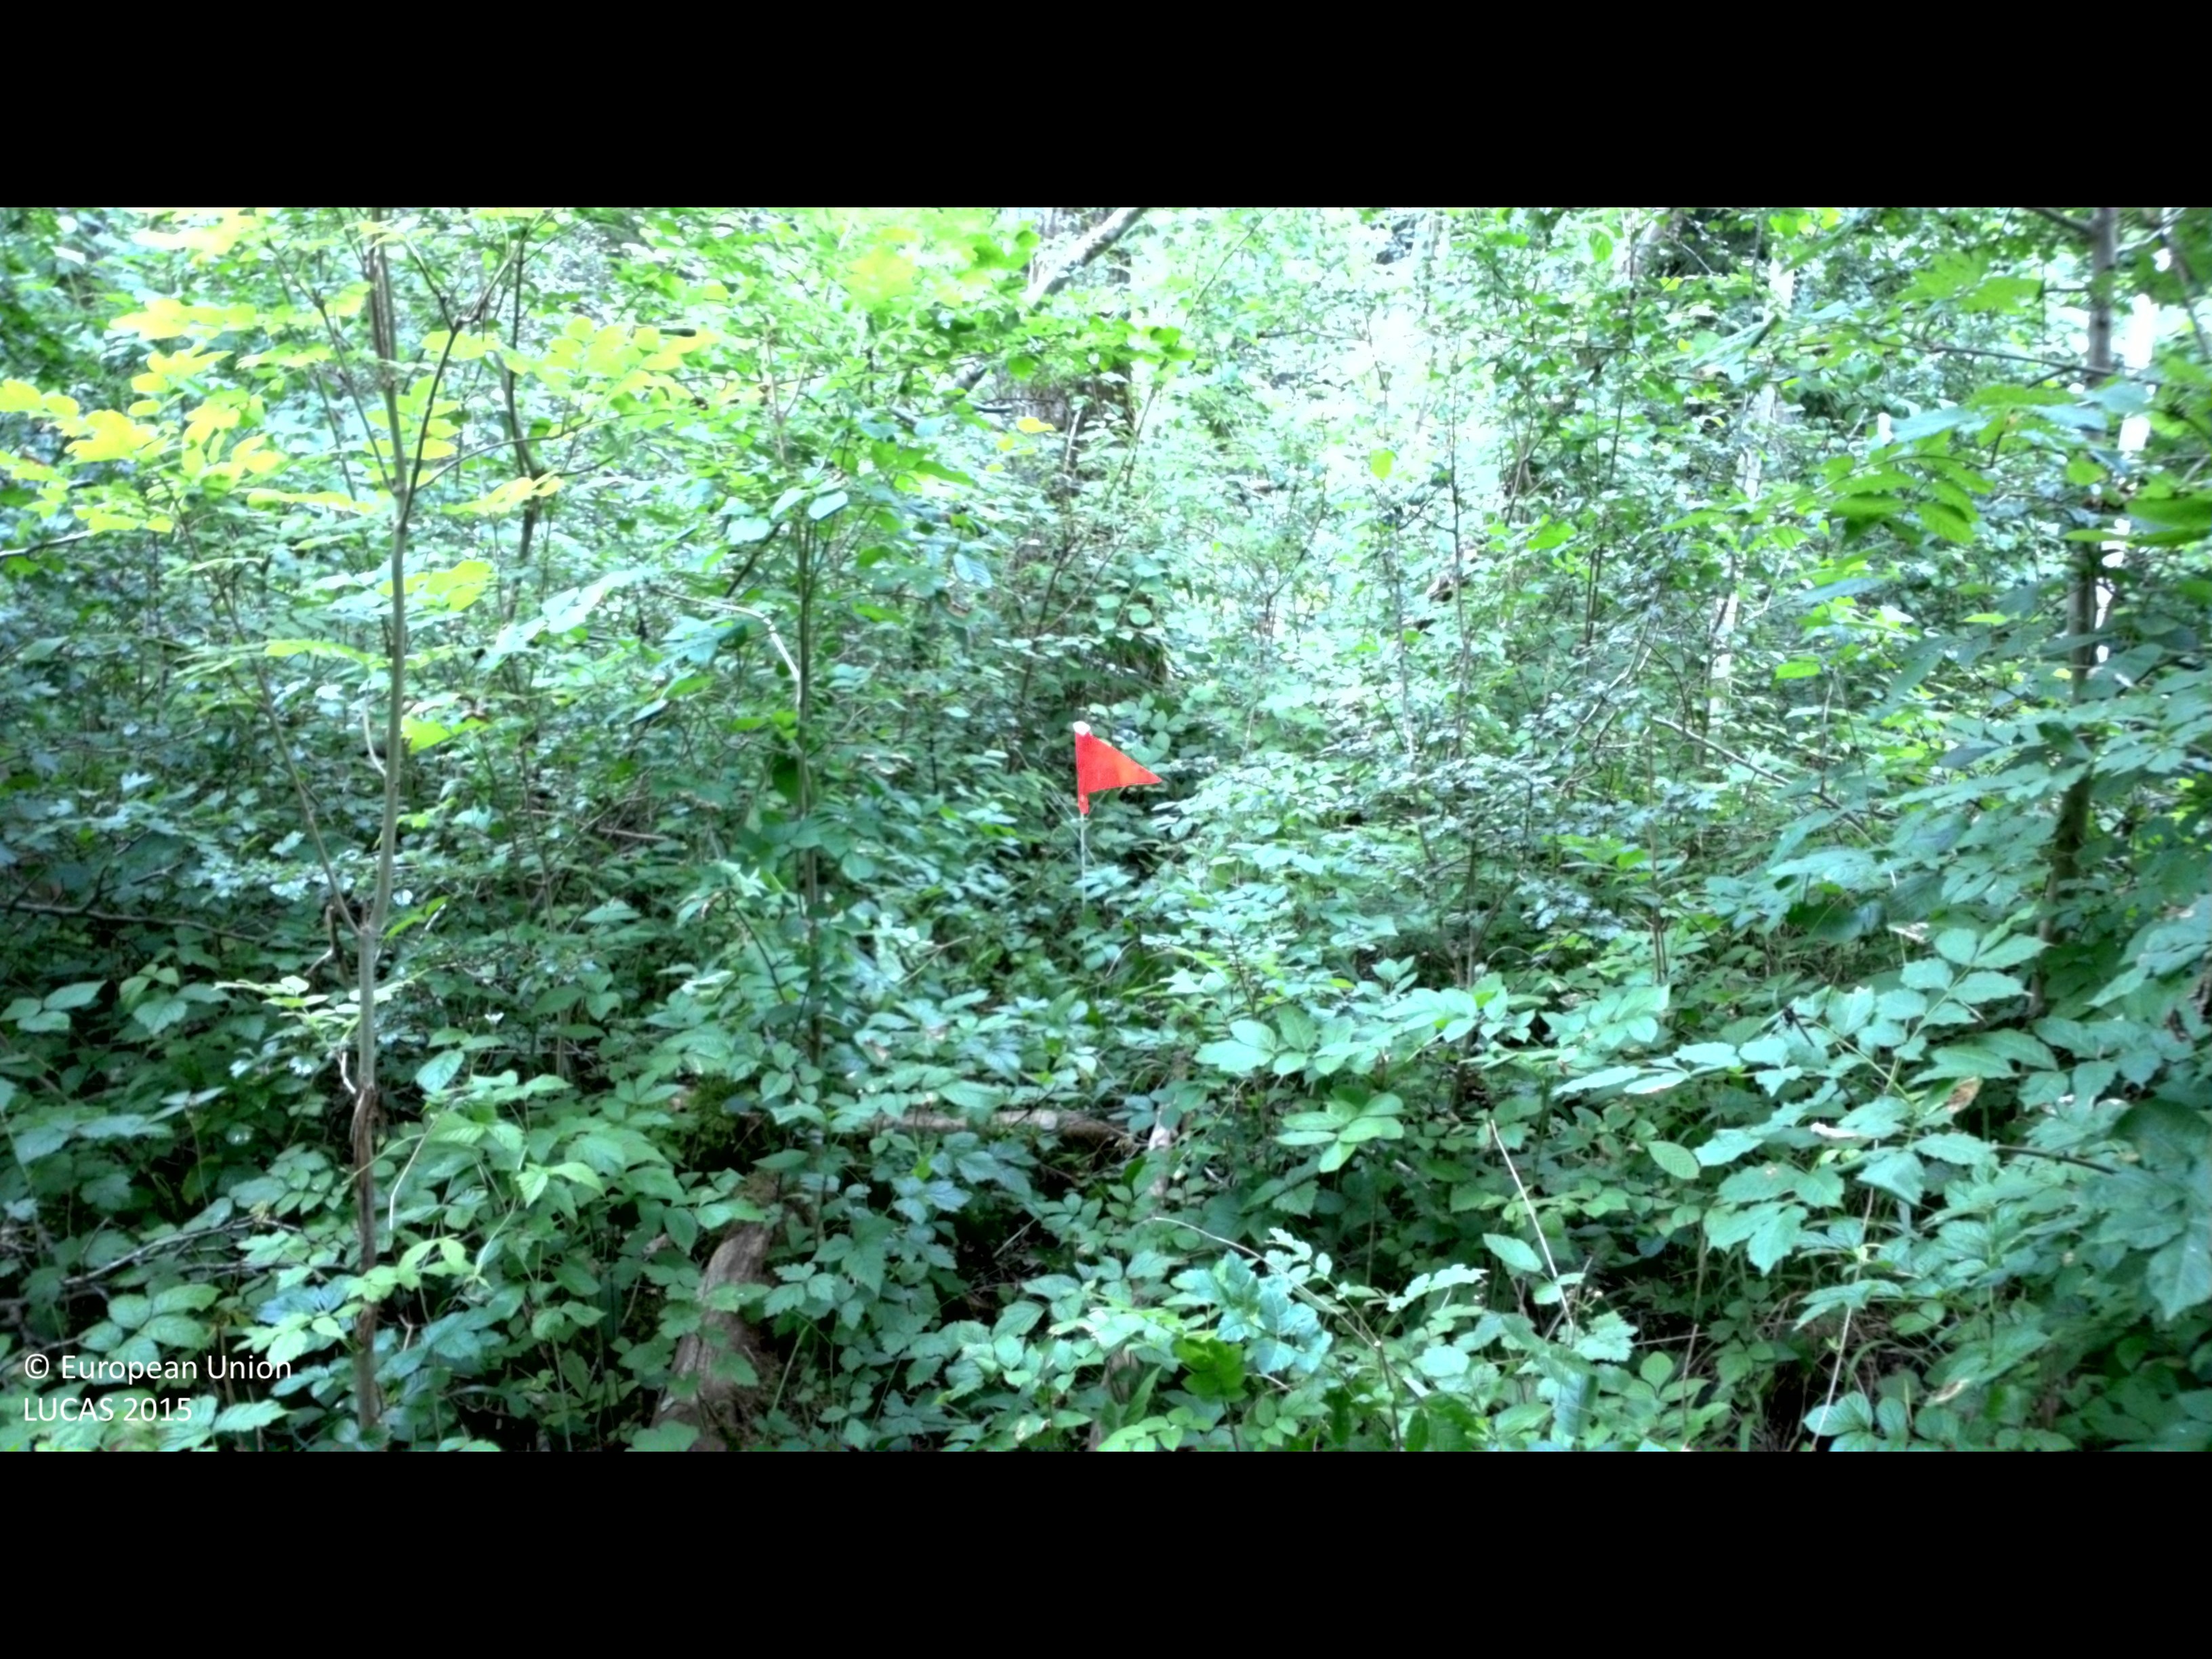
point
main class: Woodland
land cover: Broadleaved woodland
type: mesophytic deciduous forest
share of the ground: 50 - 75 %
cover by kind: broadleaved forest trees 50 %, shrubs 30 %, coniferous forest trees 15 %, herbaceous plants 5 %
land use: Forestry
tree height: > 5 m
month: July
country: SE
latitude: 56.7419
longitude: 16.5576
